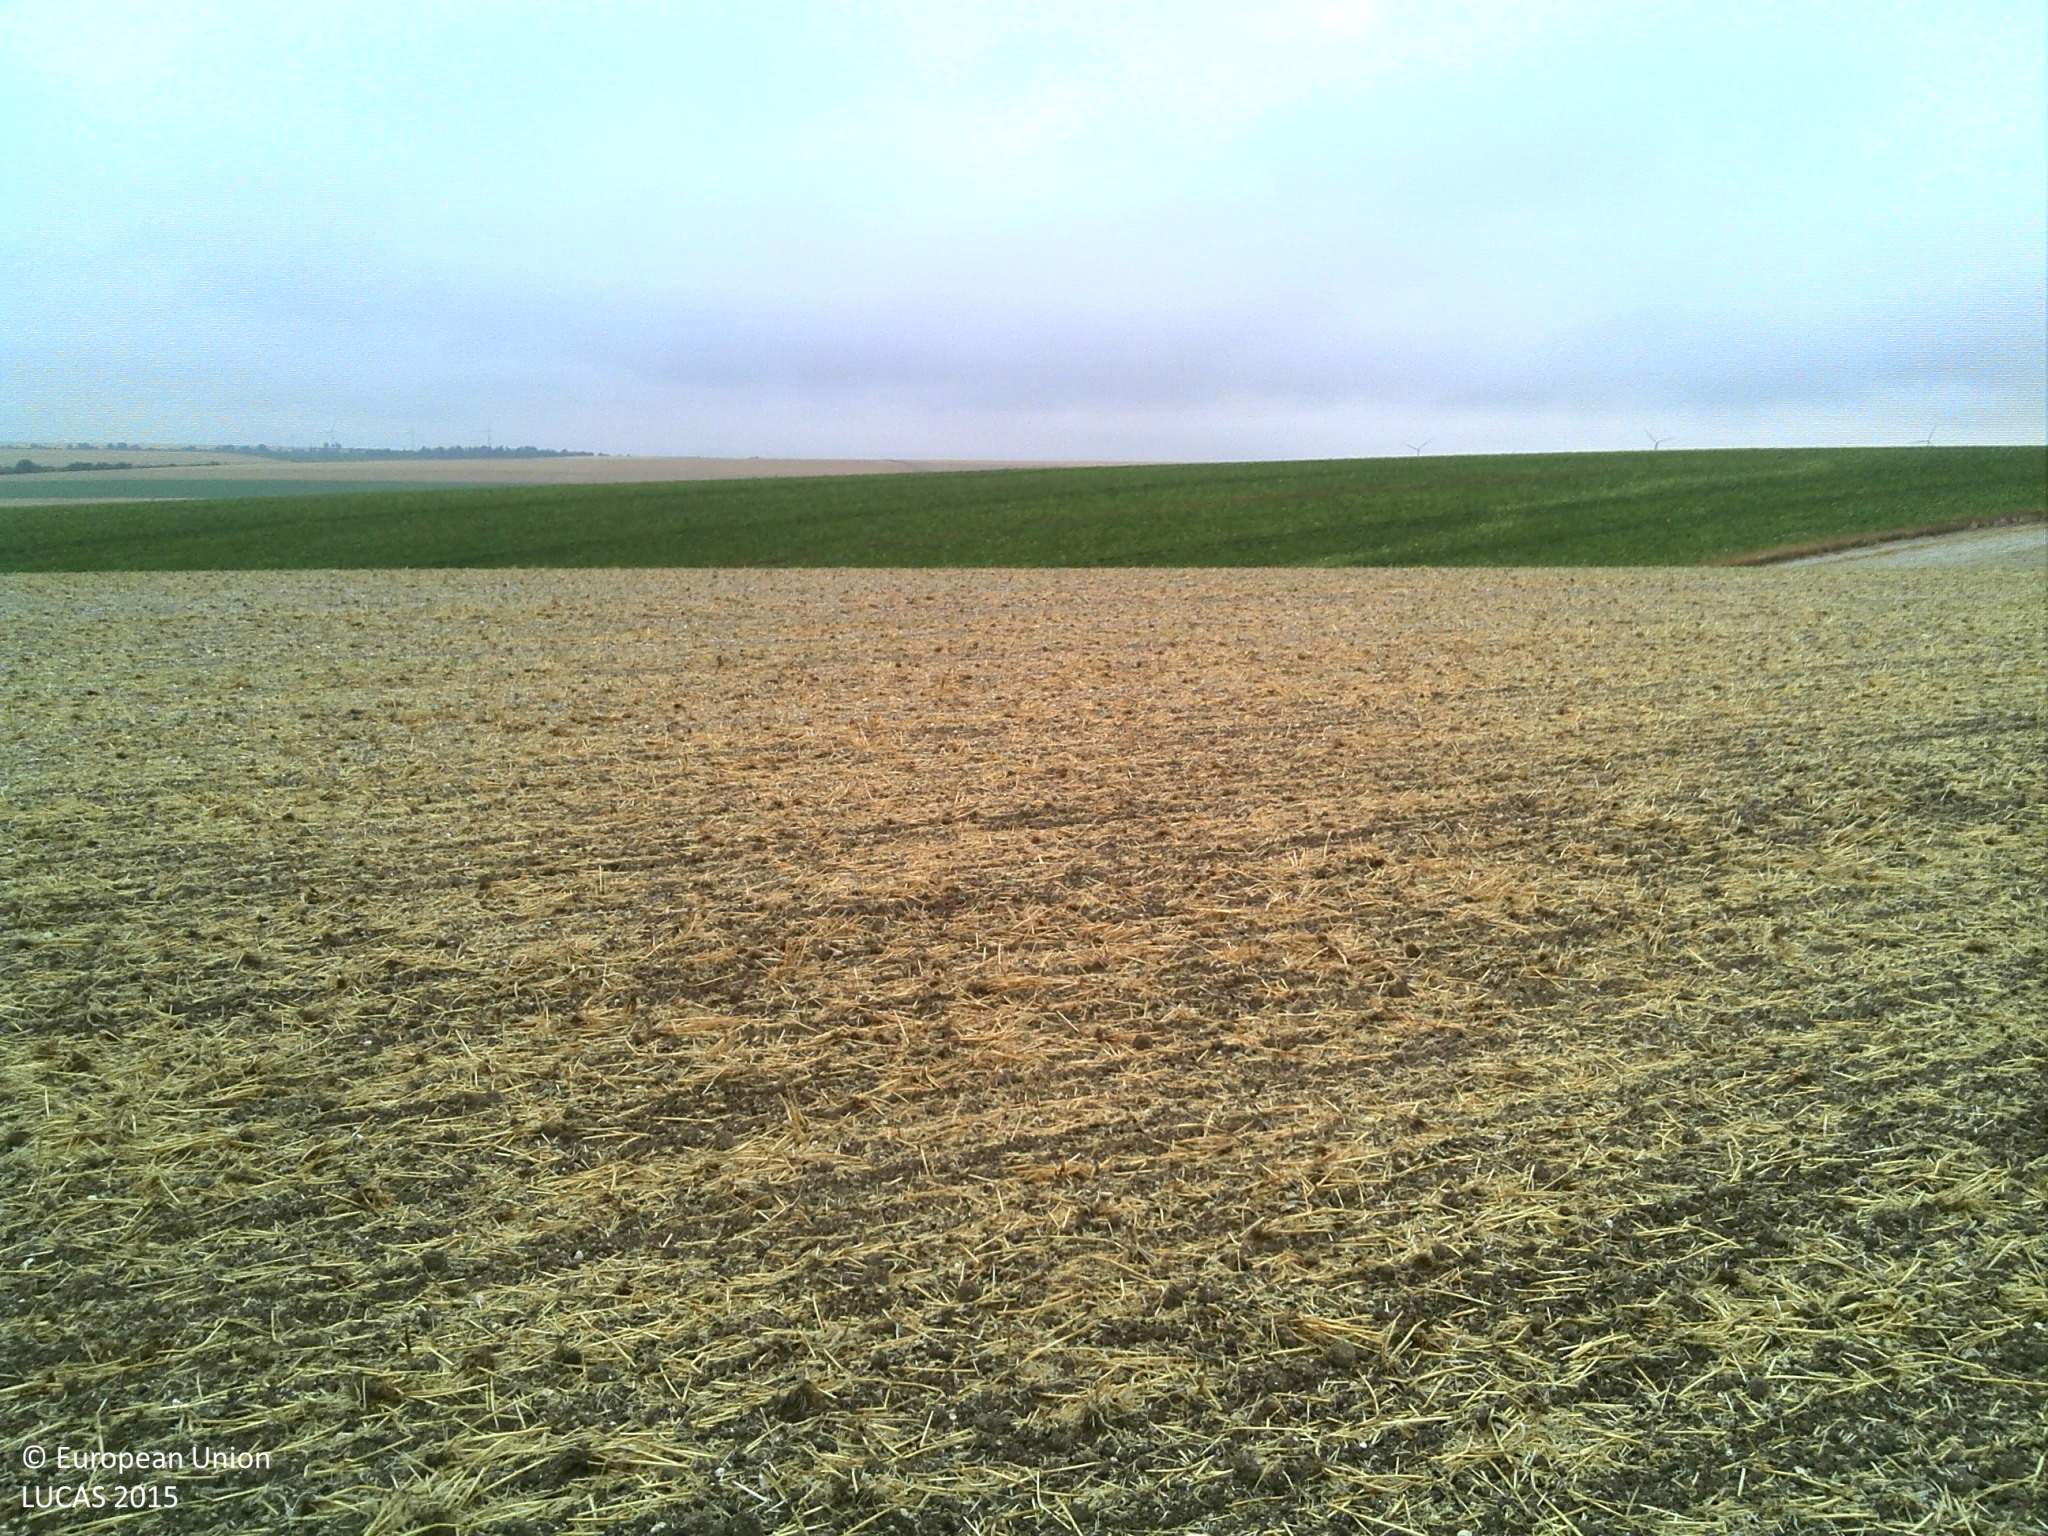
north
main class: Cropland
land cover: Common wheat
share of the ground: > 75 %
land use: Agriculture (excluding fallow land and kitchen gardens)
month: August
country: FR
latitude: 48.8326
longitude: 4.6433
